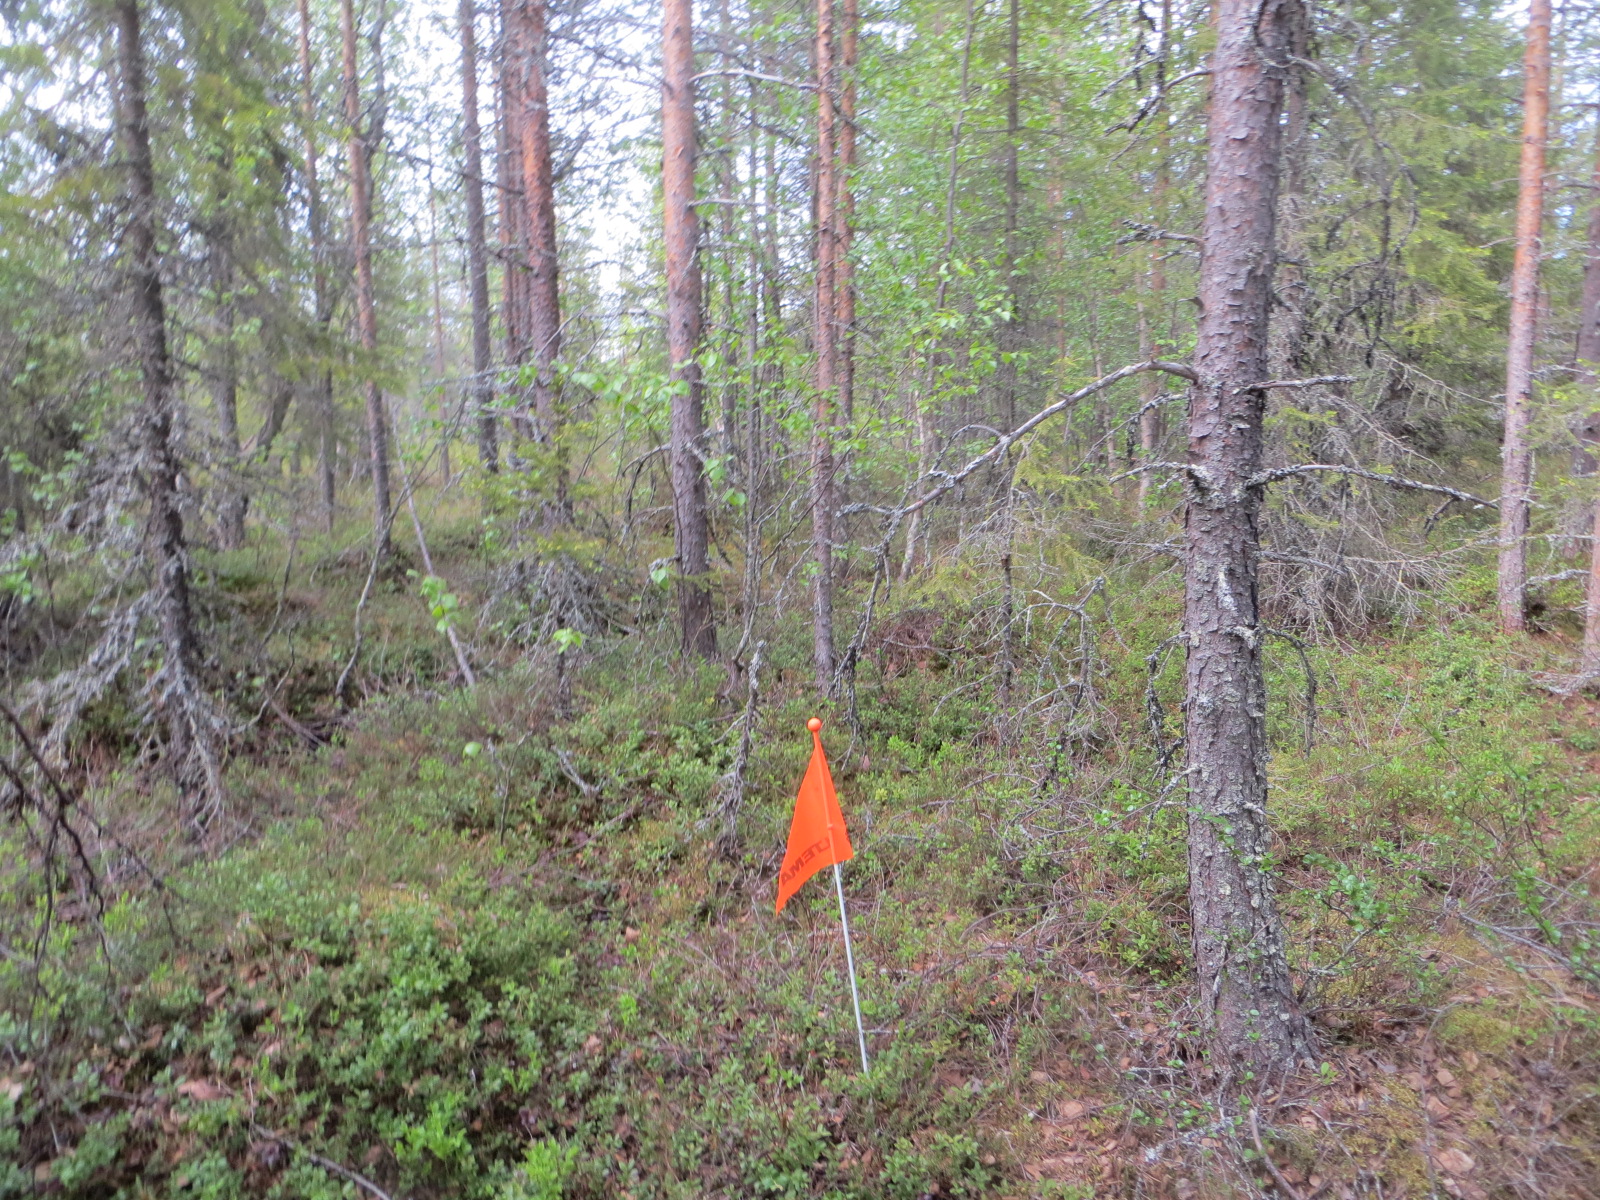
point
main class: Woodland
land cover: Pine dominated mixed woodland
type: boreal forest
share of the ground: > 75 %
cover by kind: coniferous forest trees 60 %, broadleaved forest trees 25 %, shrubs 15 %
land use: Forestry
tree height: > 5 m
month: June
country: FI
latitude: 67.1322
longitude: 25.0579
